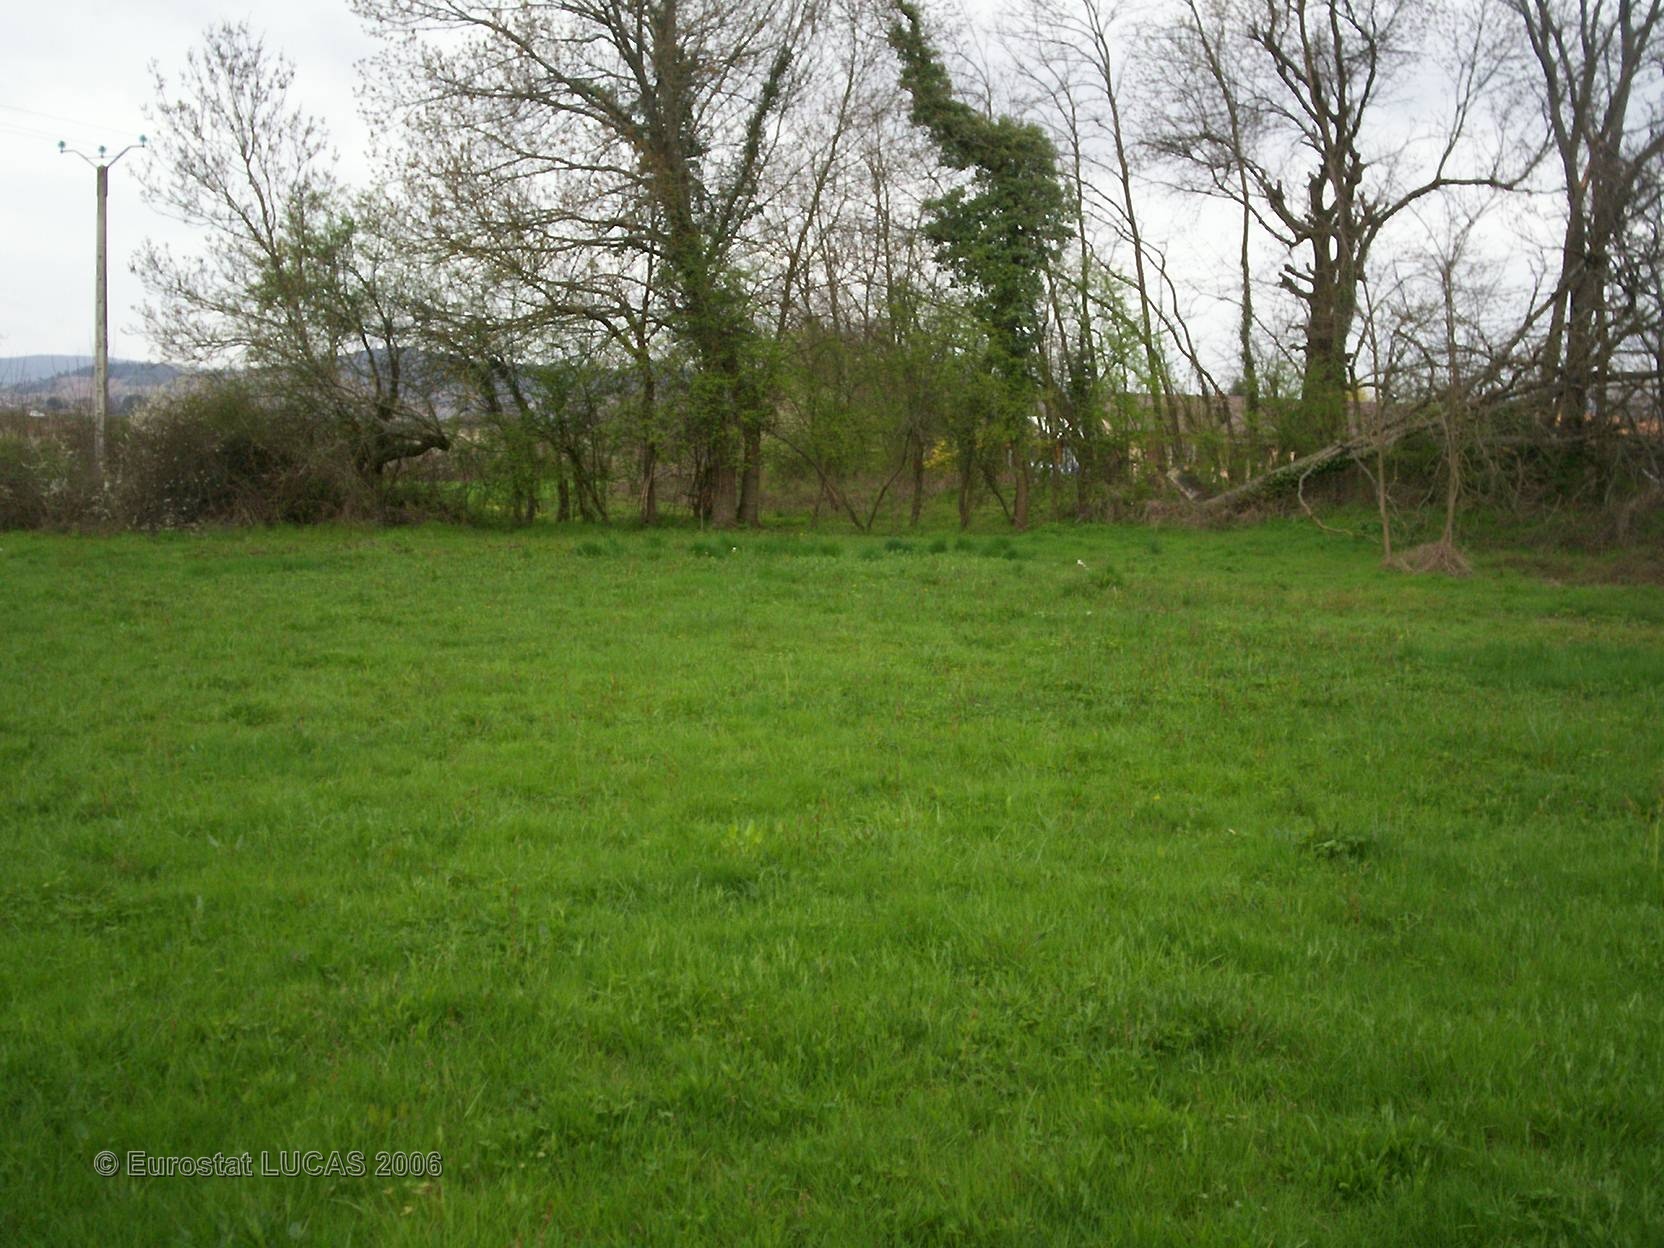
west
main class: Grassland
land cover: Grassland without tree/shrub cover
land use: Agriculture (excluding fallow land and kitchen gardens)
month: April
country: FR
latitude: 46.2044
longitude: 4.7535
